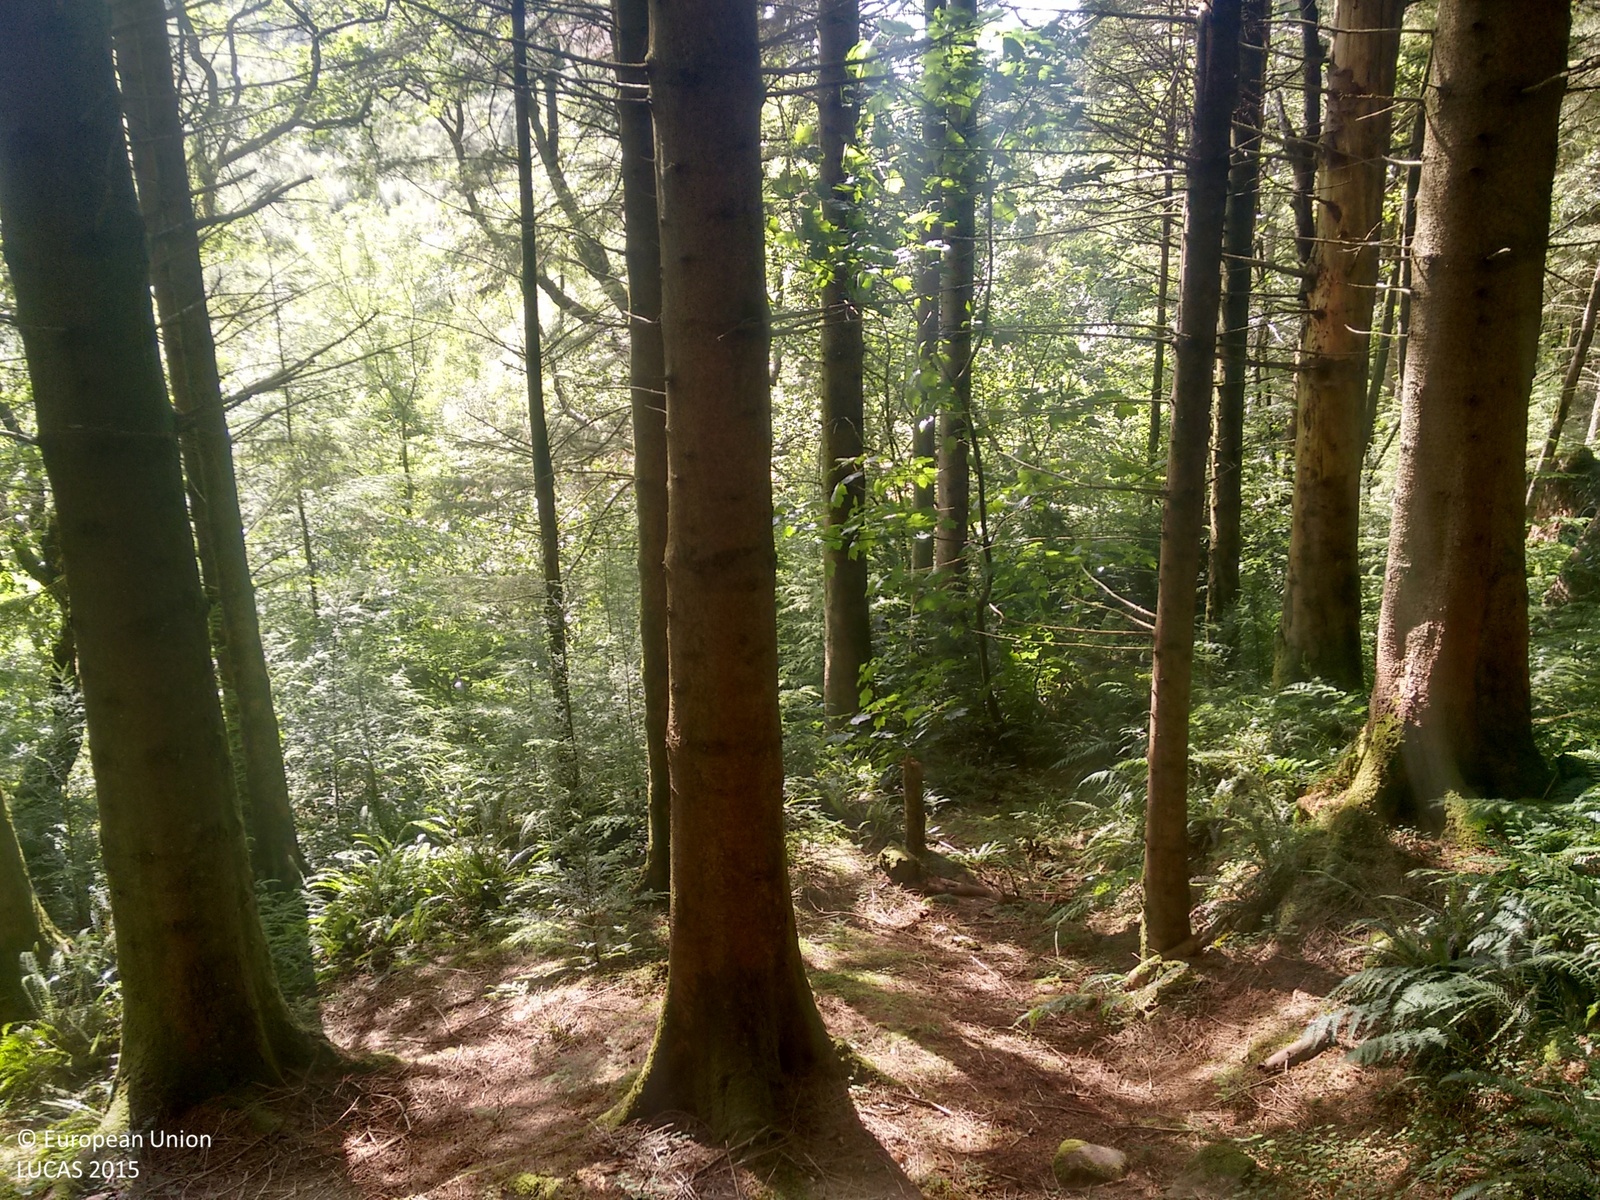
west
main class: Woodland
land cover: Pine dominated coniferous woodland
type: exotic forest
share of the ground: > 75 %
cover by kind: coniferous forest trees 90 %, broadleaved forest trees 10 %
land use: Forestry
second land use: Amenities, museums, leisure
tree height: > 5 m
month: July
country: GB
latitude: 55.5194
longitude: -5.1460
